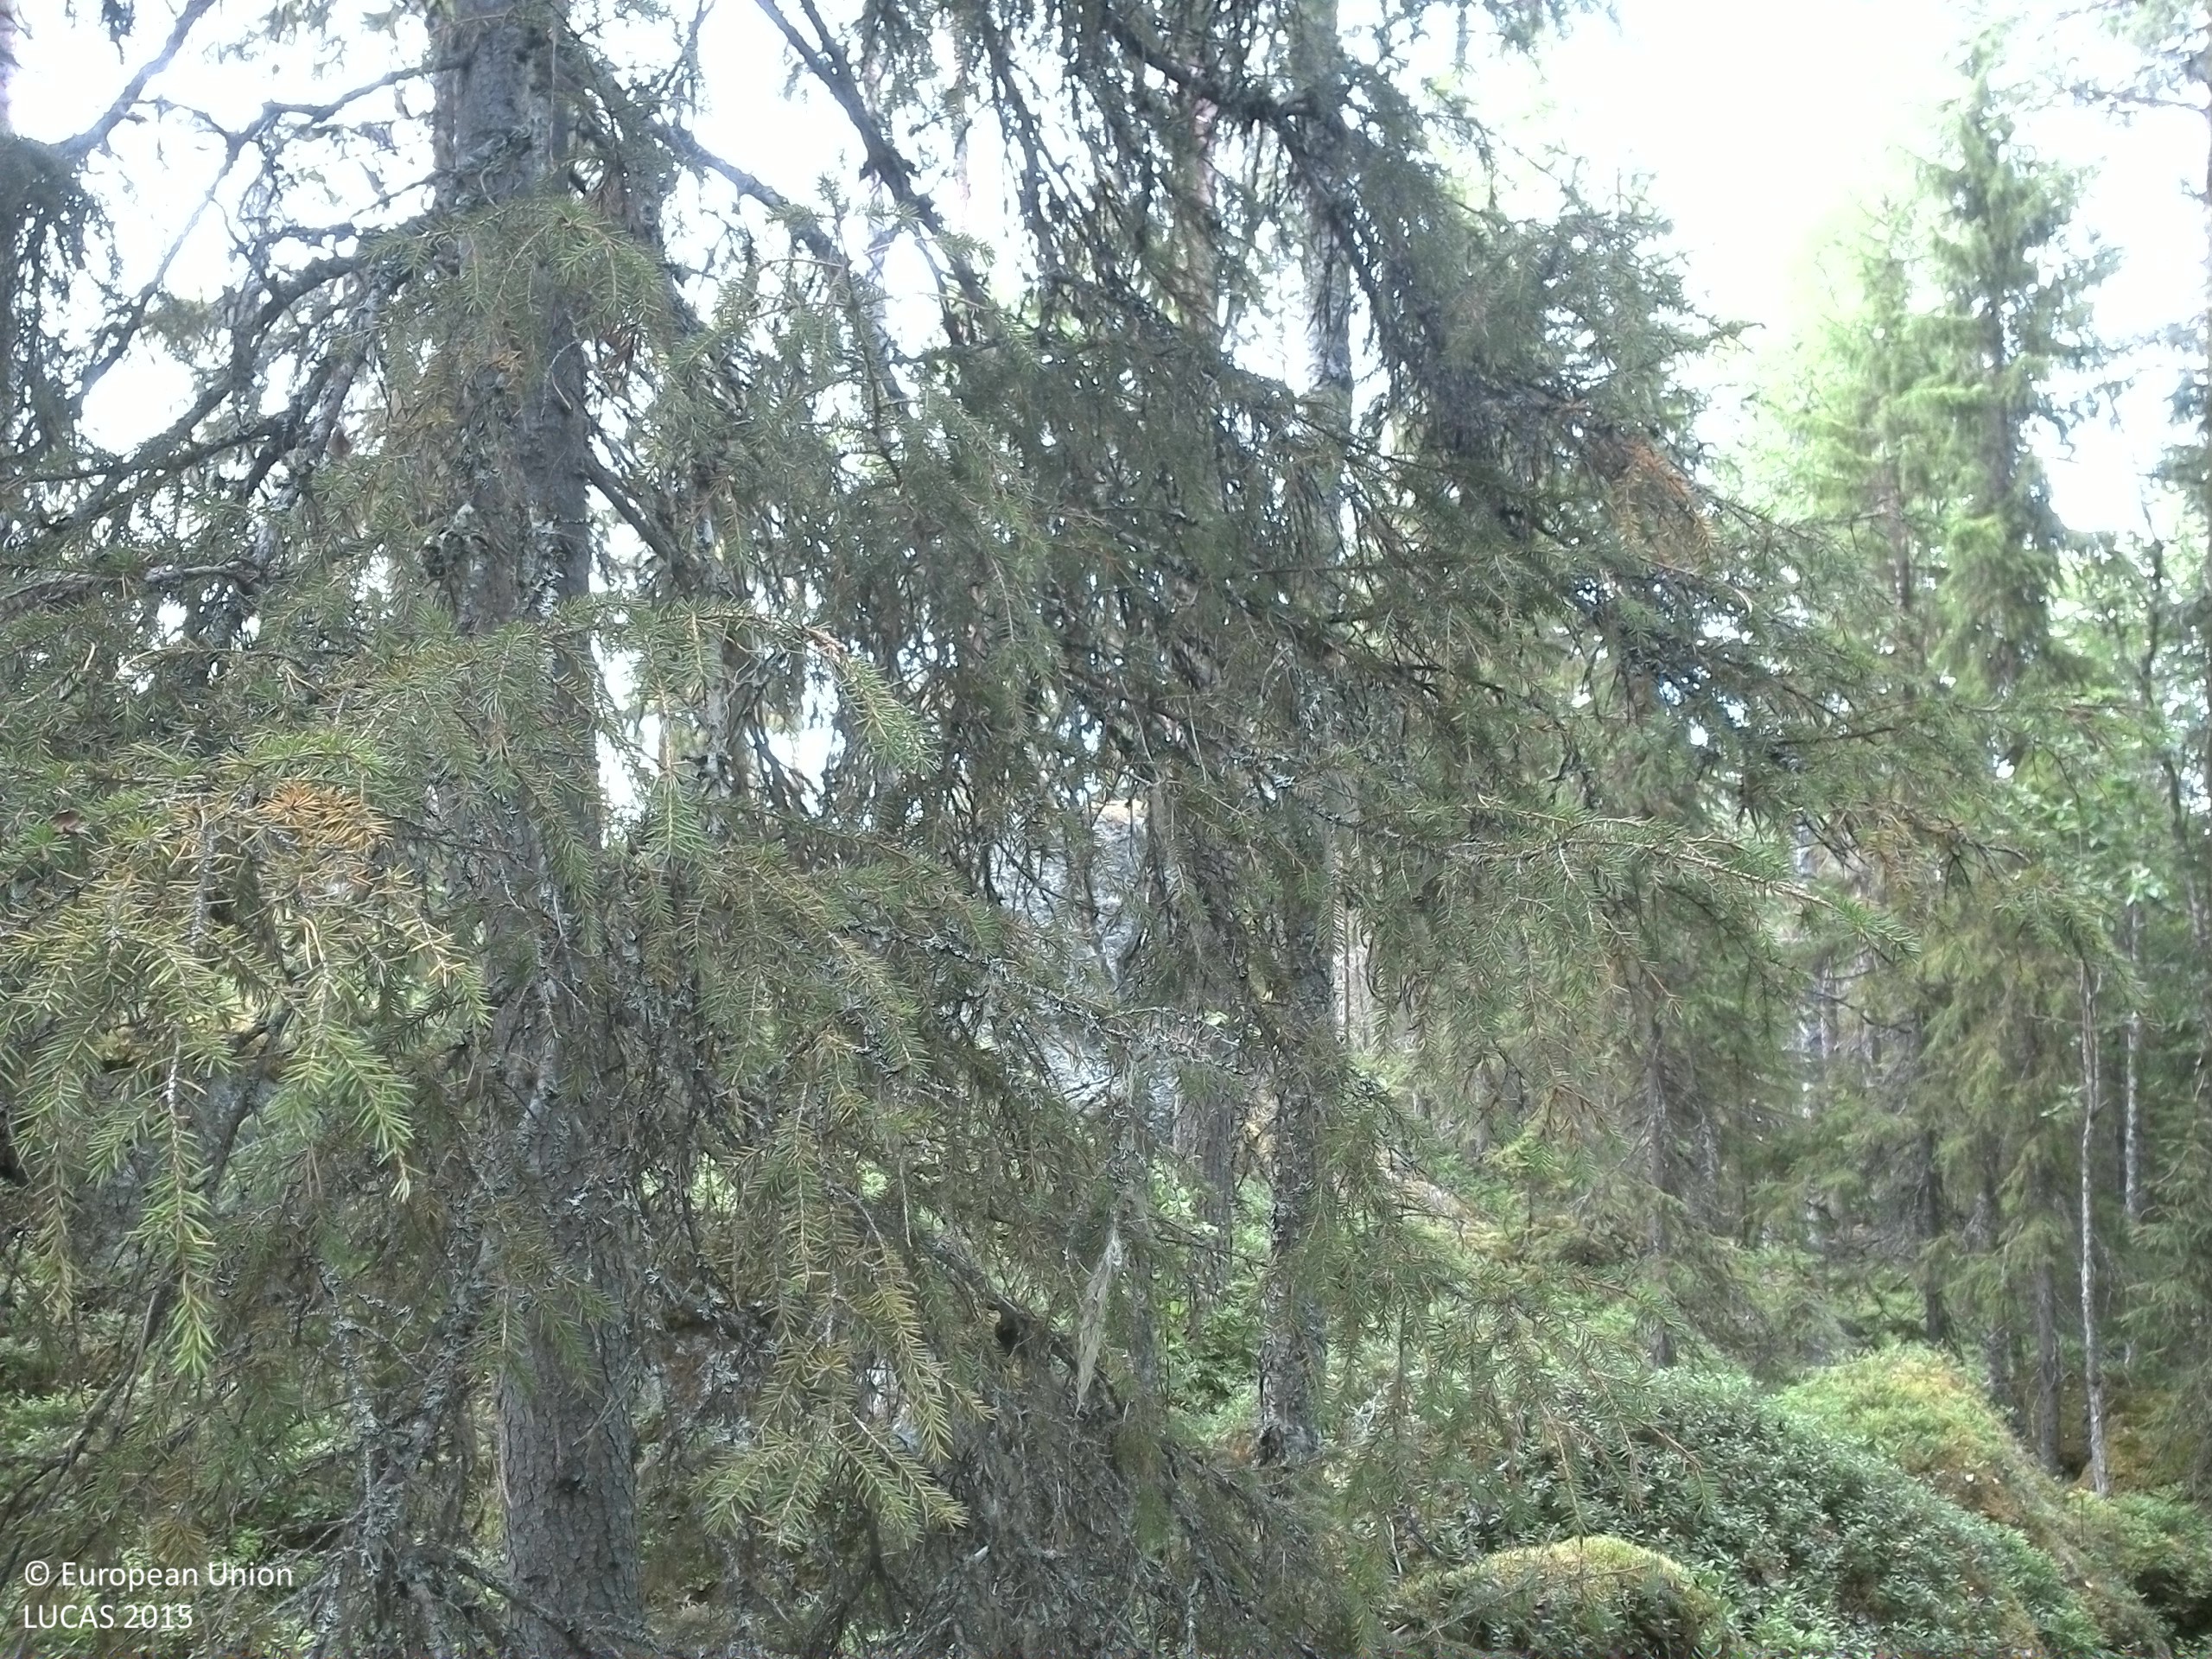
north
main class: Woodland
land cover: Pine dominated coniferous woodland
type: boreal forest
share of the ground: > 75 %
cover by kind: coniferous forest trees 70 %, shrubs 20 %, broadleaved forest trees 10 %
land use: Forestry
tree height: > 5 m
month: September
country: SE
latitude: 63.9944
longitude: 17.6774
